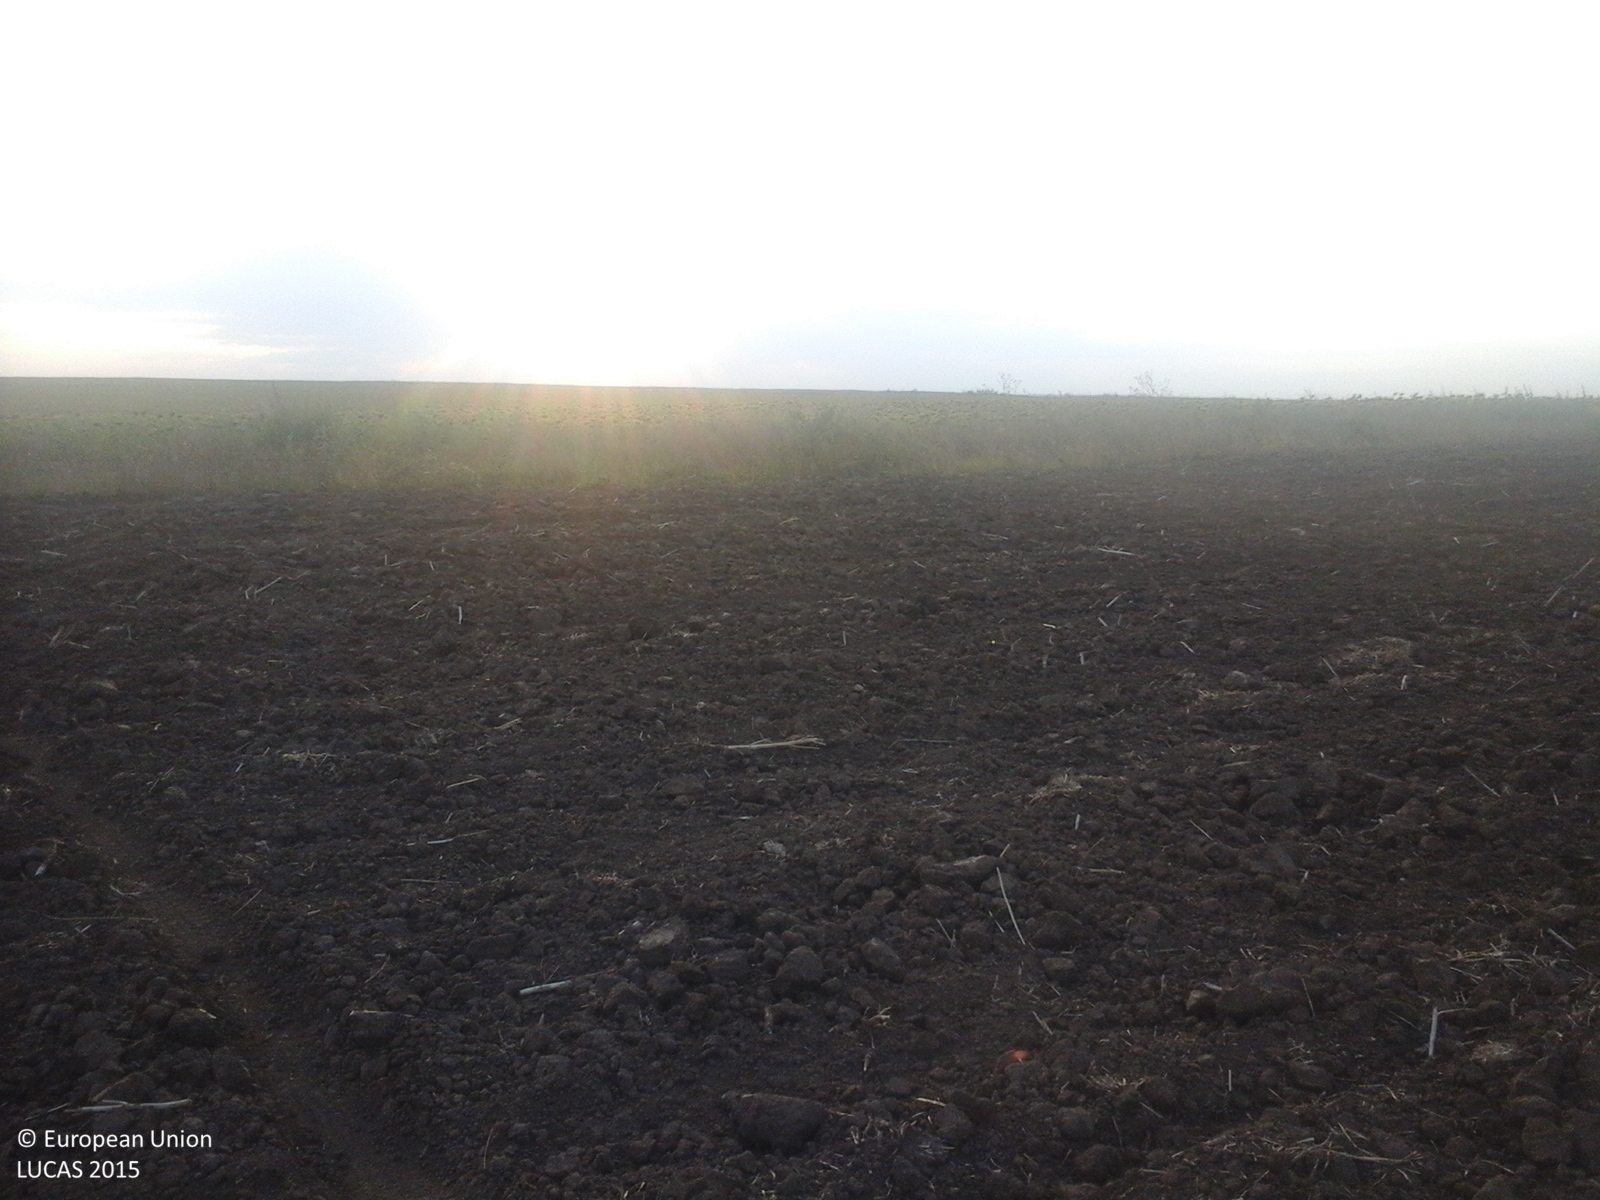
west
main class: Cropland
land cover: Rape and turnip rape
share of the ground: < 10 %
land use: Agriculture (excluding fallow land and kitchen gardens)
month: August
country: RO
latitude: 44.1235
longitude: 28.1149
